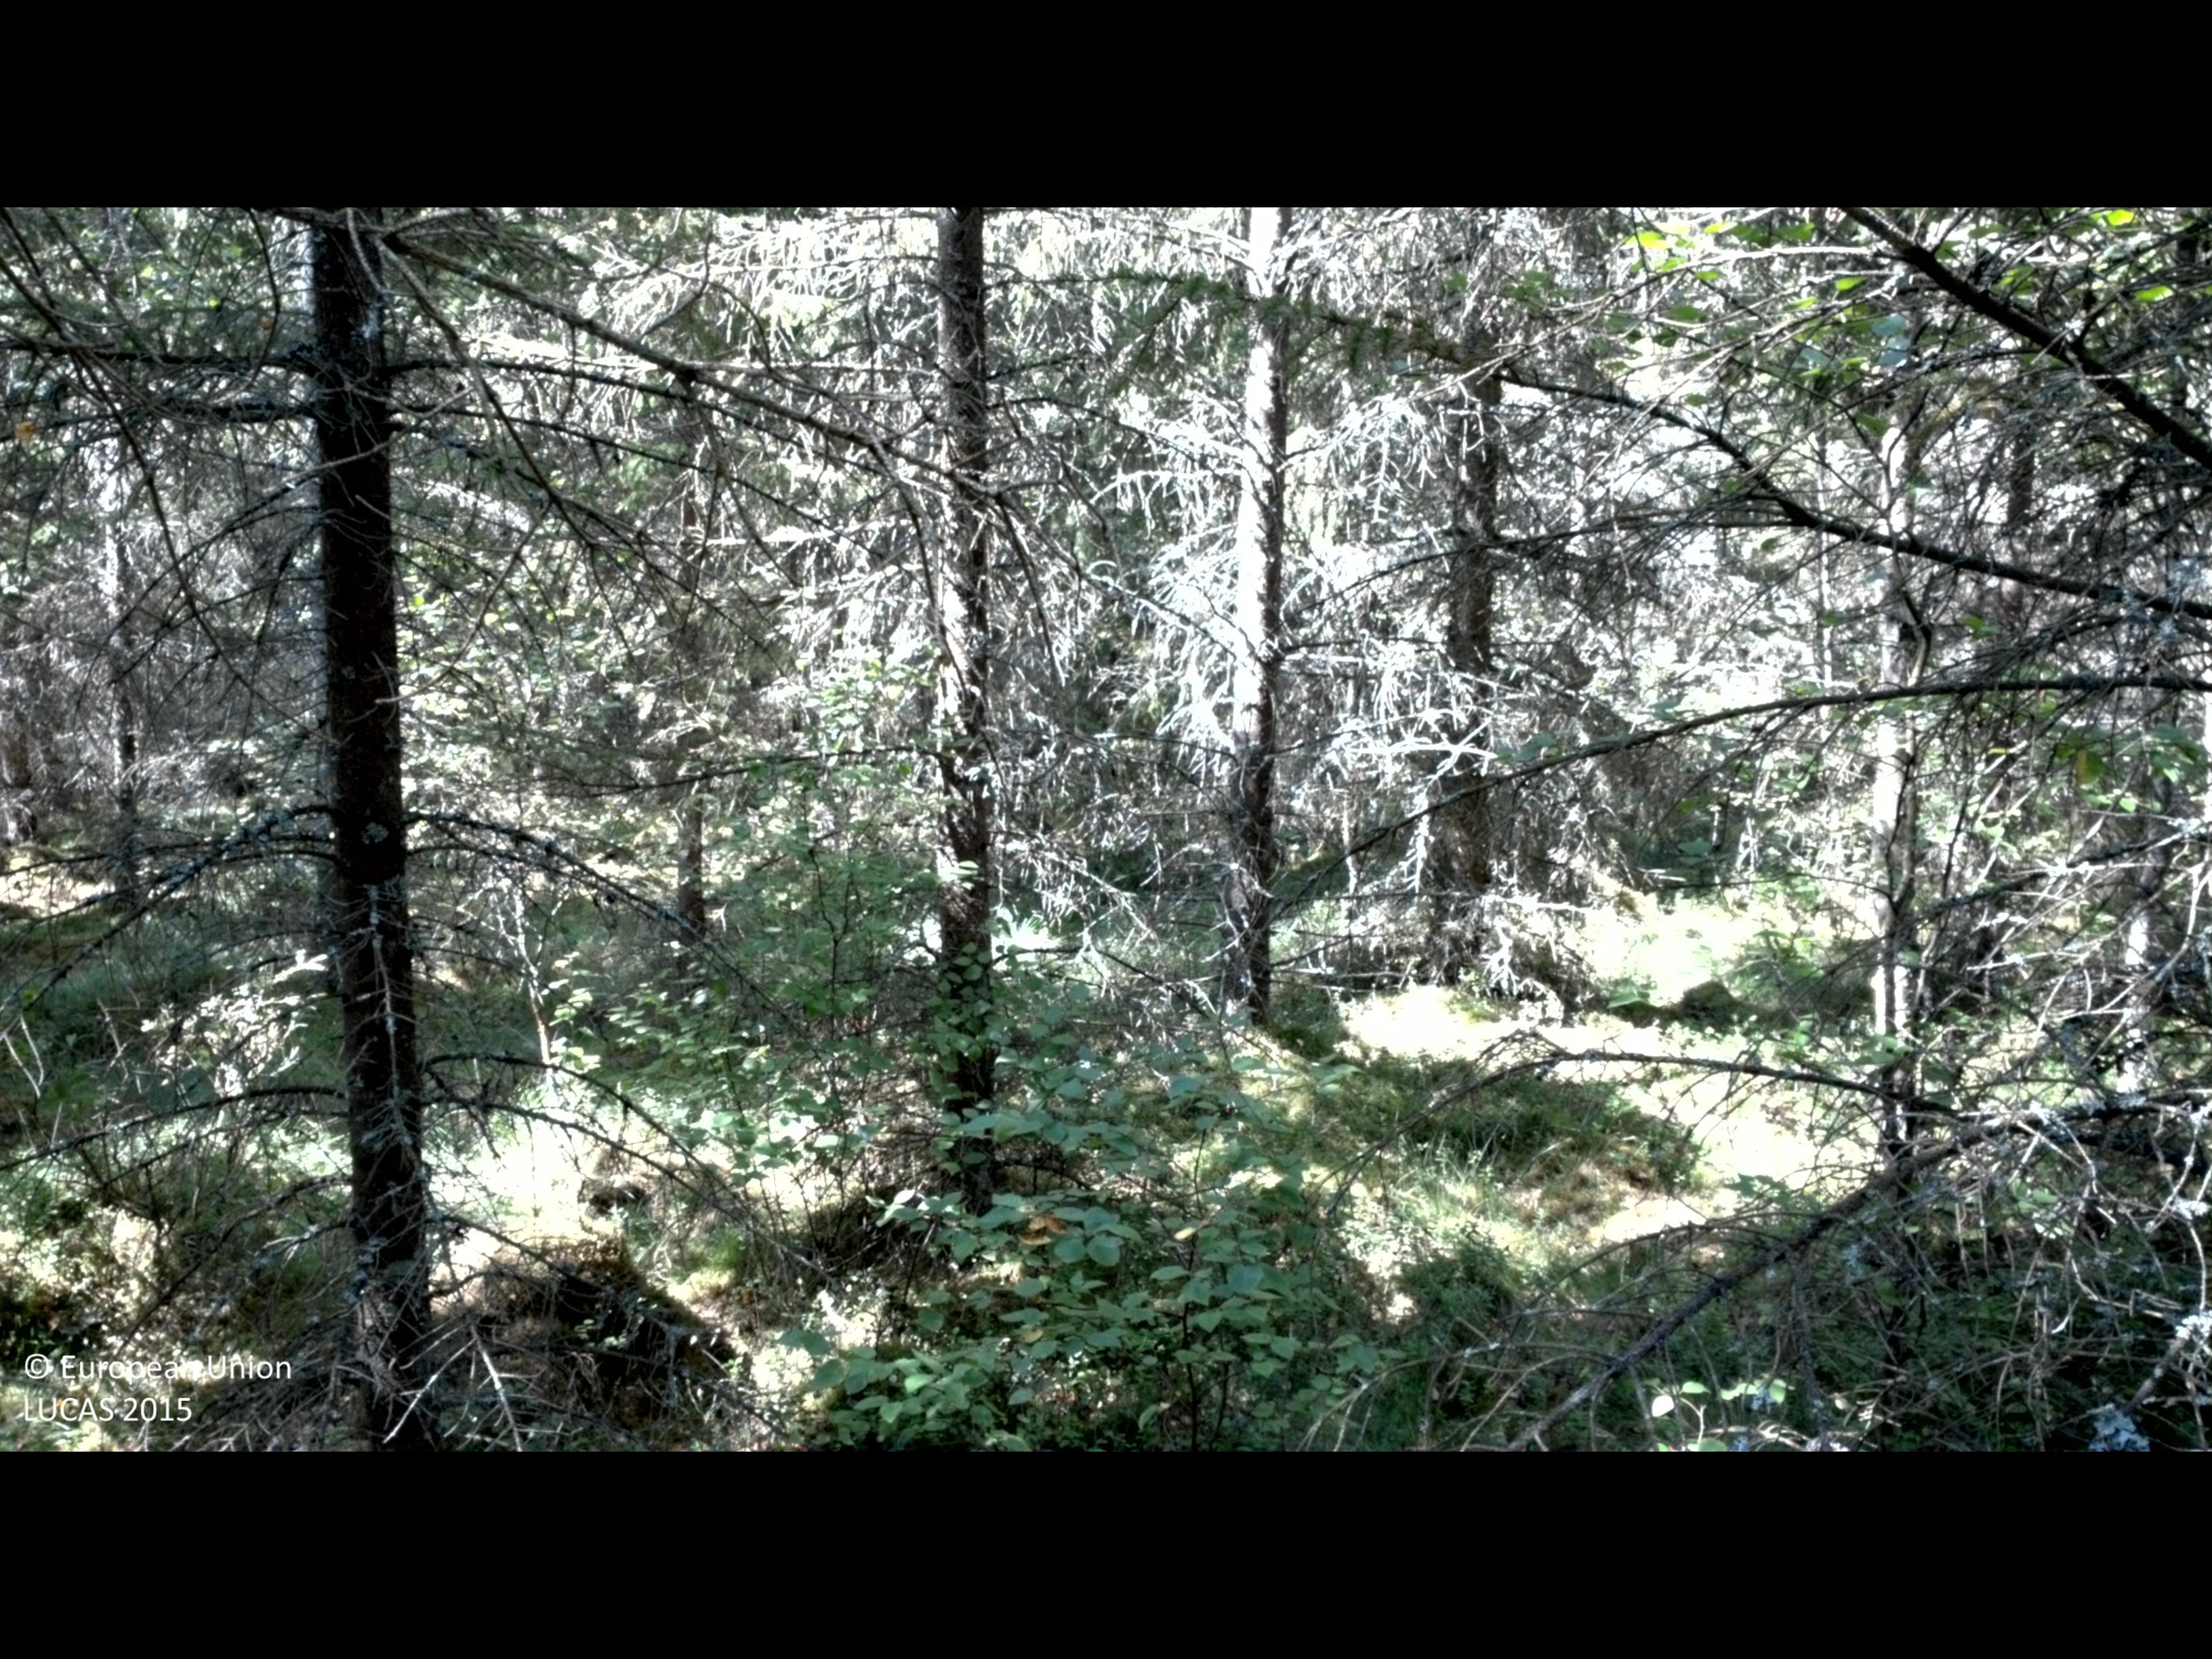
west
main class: Woodland
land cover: Spruce dominated coniferous woodland
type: boreal forest
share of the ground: > 75 %
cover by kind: coniferous forest trees 60 %, broadleaved forest trees 15 %, shrubs 15 %, herbaceous plants 5 %, lichens and mosses 5 %
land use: Forestry
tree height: > 5 m
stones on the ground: 10 - 25 %
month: August
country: SE
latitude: 56.9757
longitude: 13.8626
